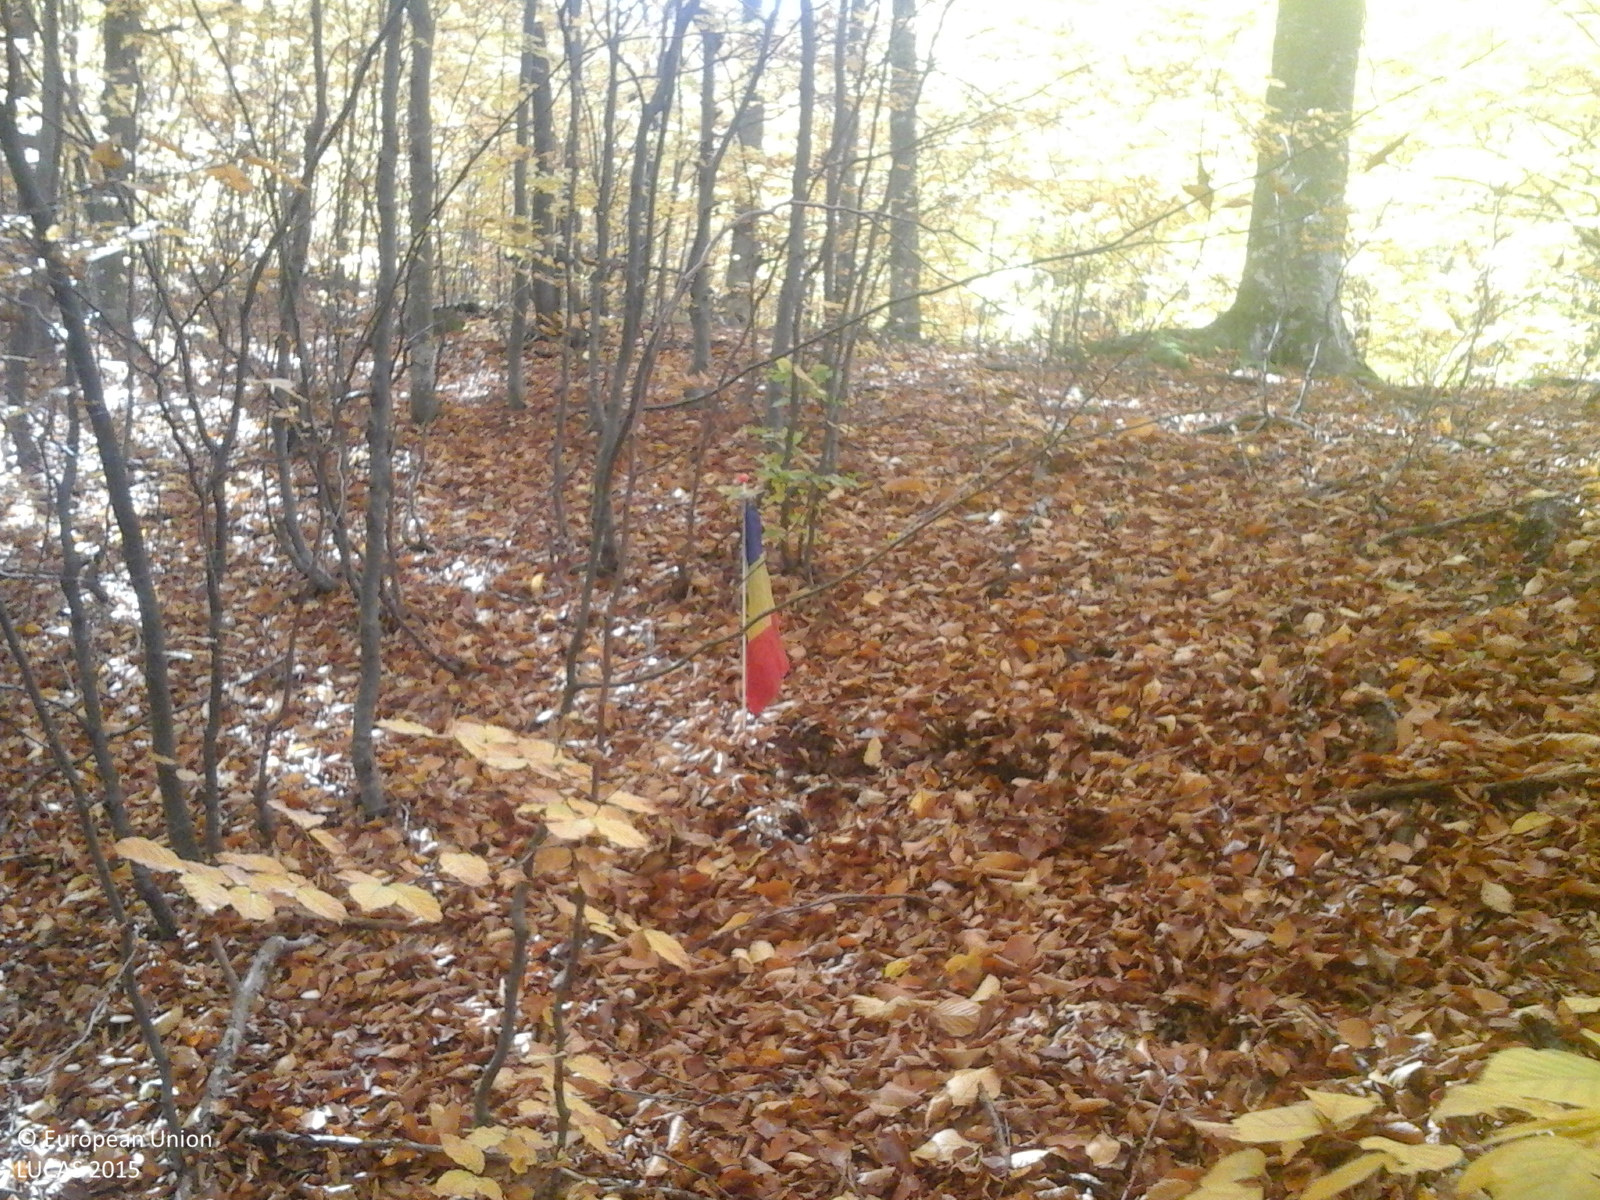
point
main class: Woodland
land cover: Broadleaved woodland
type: beech forest
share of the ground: > 75 %
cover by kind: broadleaved forest trees 100 %
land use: Forestry
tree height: > 5 m
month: October
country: RO
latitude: 45.9246
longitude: 26.5988
